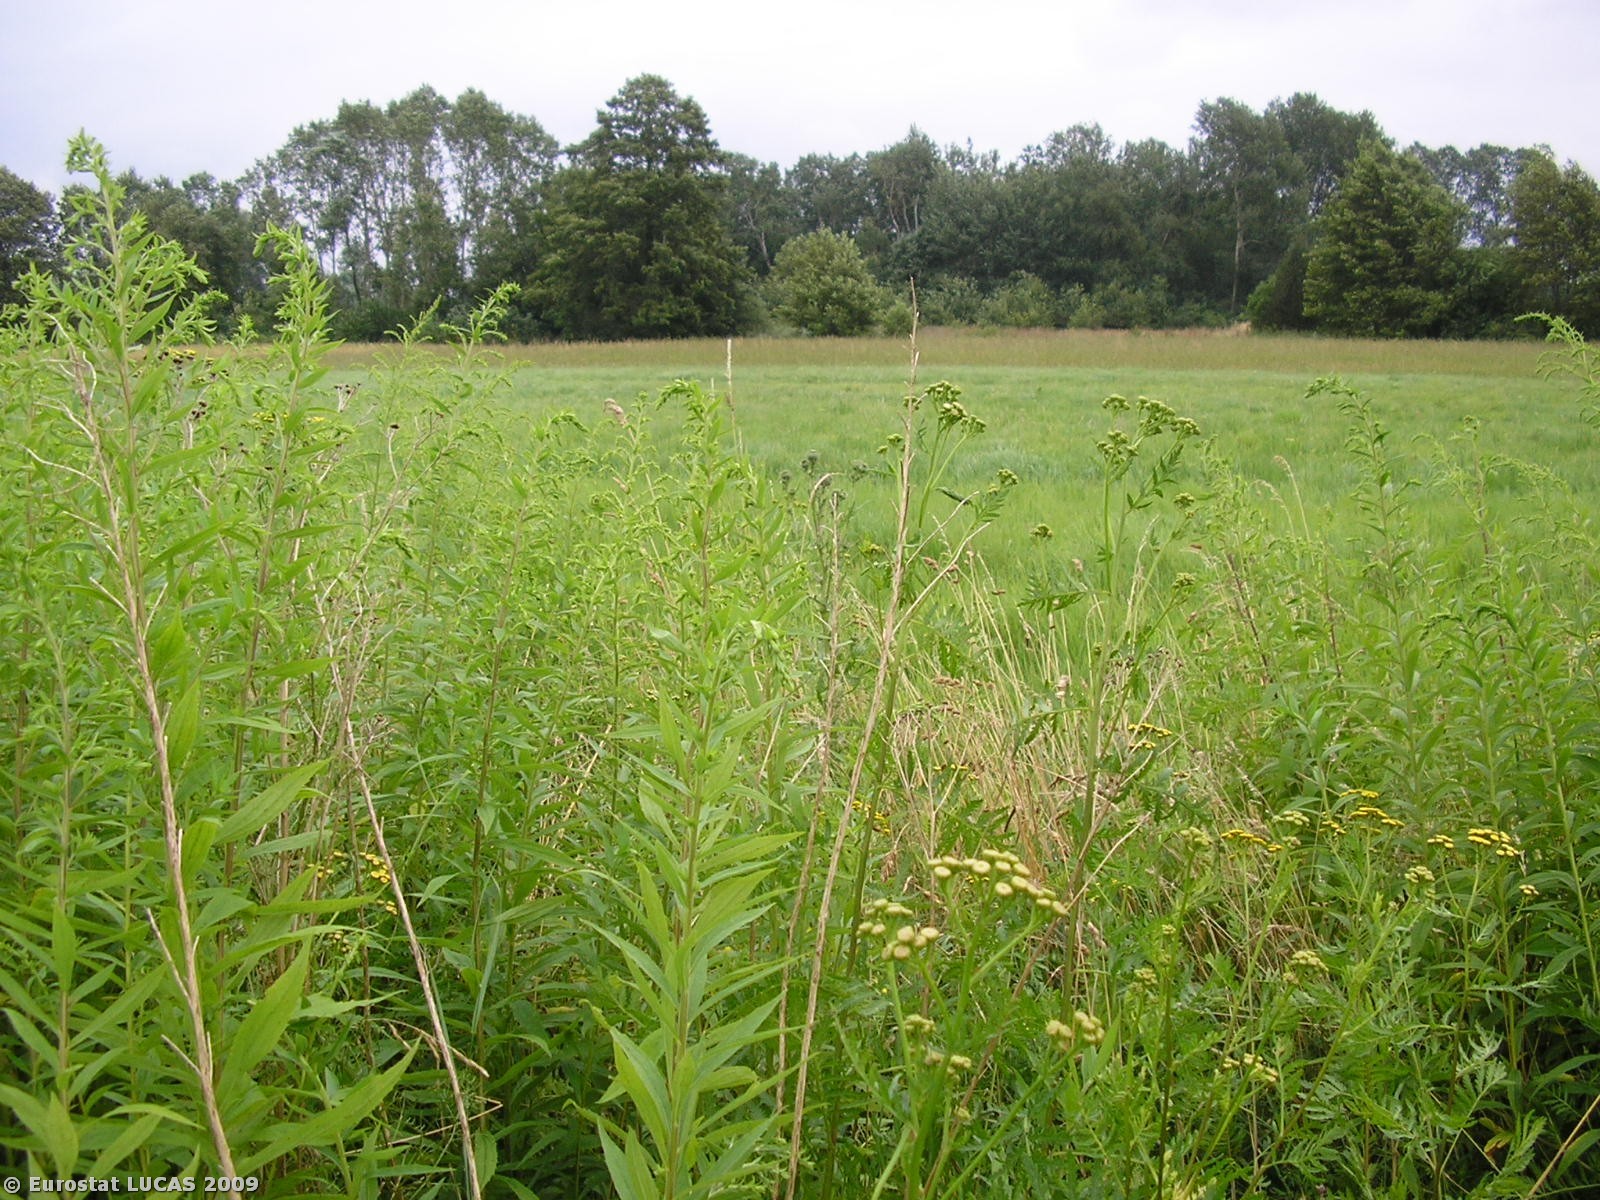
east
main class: Grassland
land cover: Spontaneously vegetated surfaces
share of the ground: > 75 %
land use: Unused
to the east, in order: Spontaneously vegetated surfaces; Grassland without tree/shrub cover; Mixed cereals for fodder; Broadleaved woodland; Grassland with sparse tree/shrub cover; Broadleaved woodland; Rye; Lines of trees; Grassland without tree/shrub cover; Rye
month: July
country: PL
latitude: 52.1950
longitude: 22.2488
